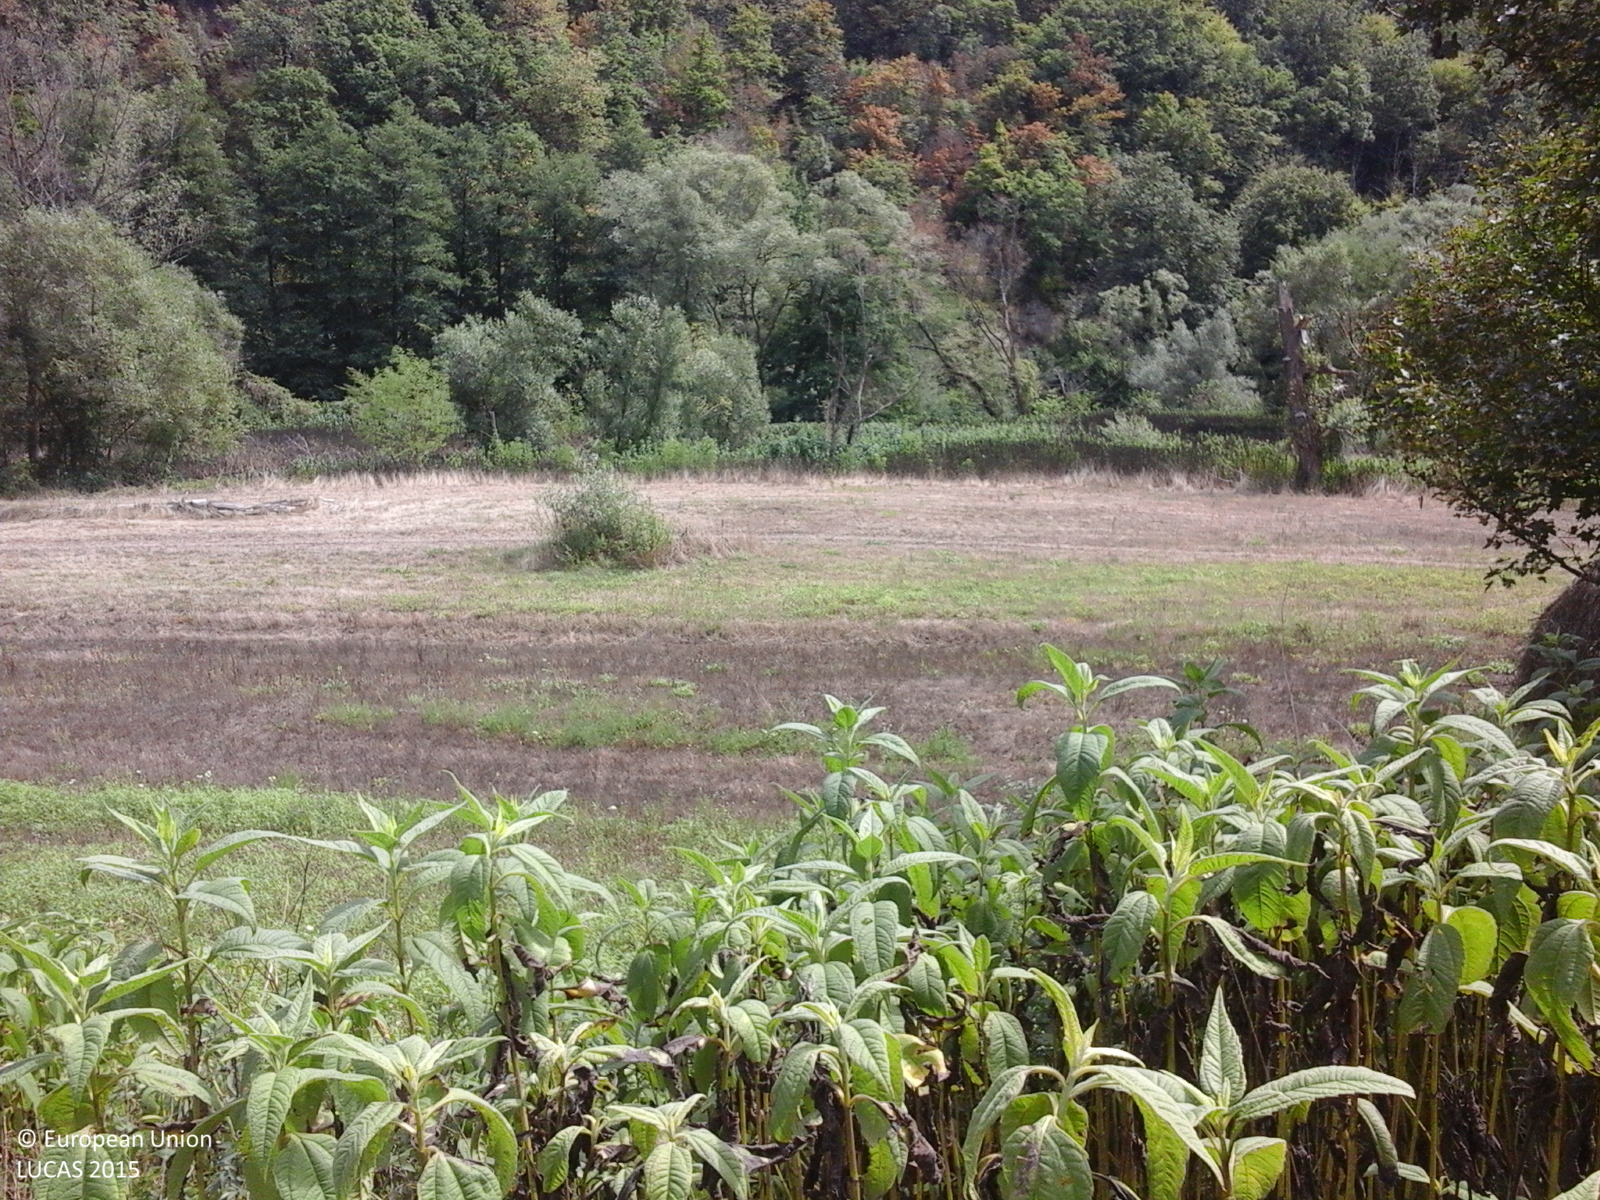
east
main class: Grassland
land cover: Spontaneously vegetated surfaces
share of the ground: > 75 %
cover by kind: herbaceous plants 100 %
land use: Fallow land
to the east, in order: Spontaneously vegetated surfaces; Lucerne; Tracks; Spontaneously vegetated surfaces; Lines of trees; Grassland without tree/shrub cover; Broadleaved woodland; Inland fresh running water; Broadleaved woodland; Tracks; Broadleaved woodland
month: August
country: RO
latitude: 44.8334
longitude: 21.8594
